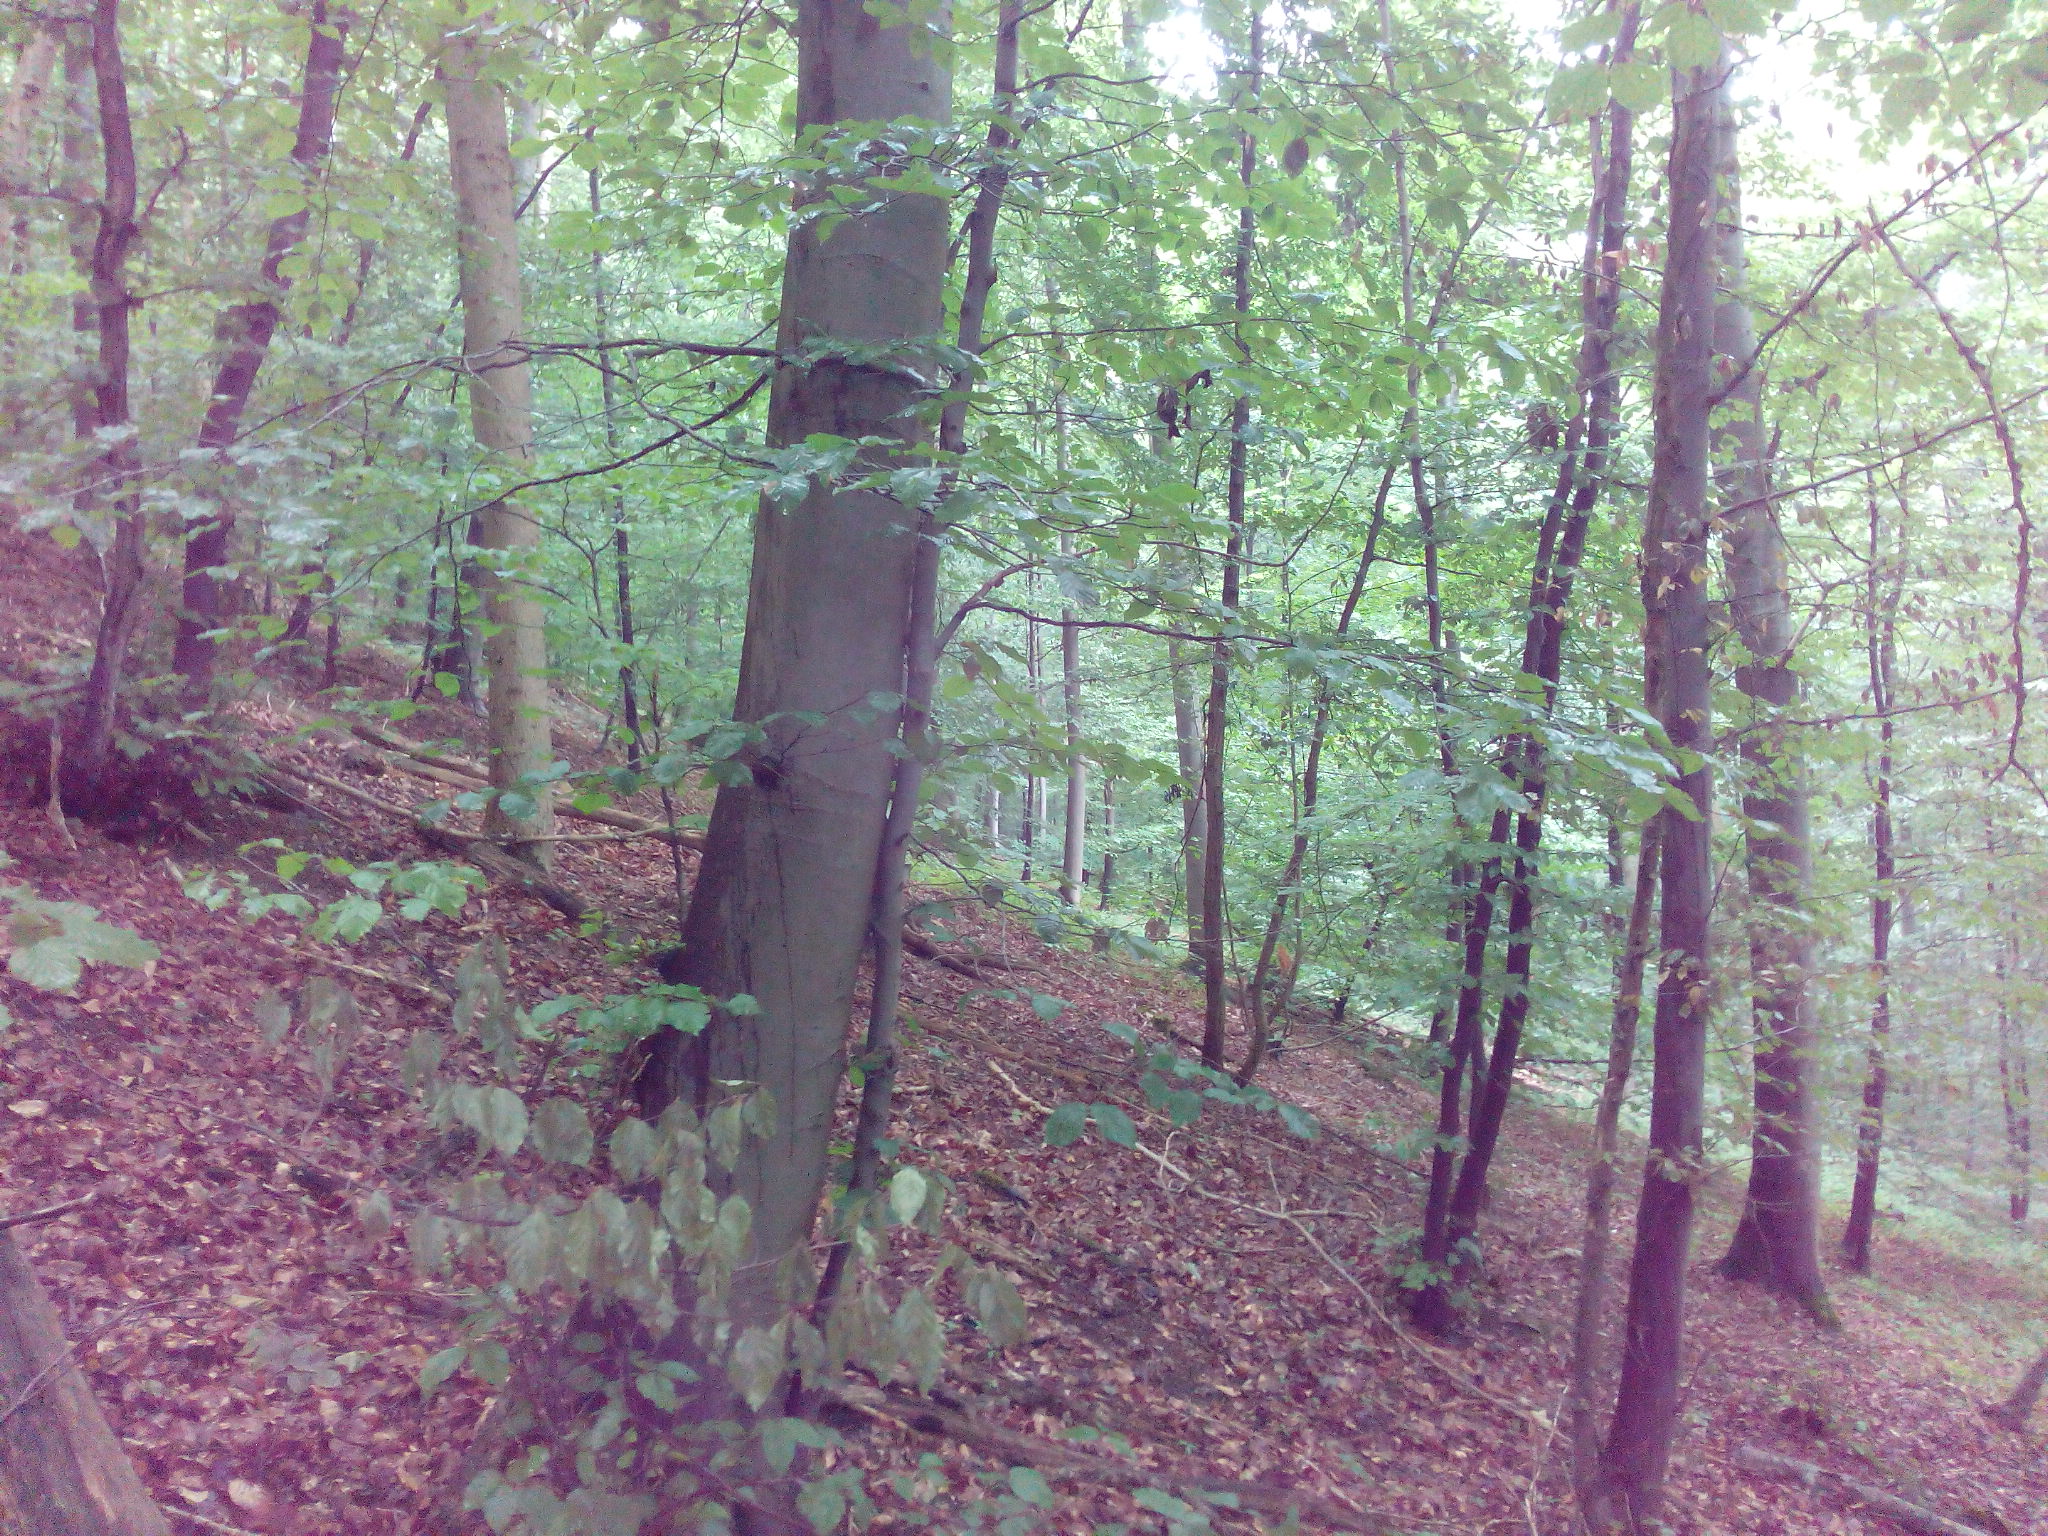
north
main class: Woodland
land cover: Broadleaved woodland
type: mesophytic deciduous forest
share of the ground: > 75 %
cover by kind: broadleaved forest trees 90 %, herbaceous plants 10 %
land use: Forestry
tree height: > 5 m
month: August
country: DE
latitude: 52.1437
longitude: 9.8977
